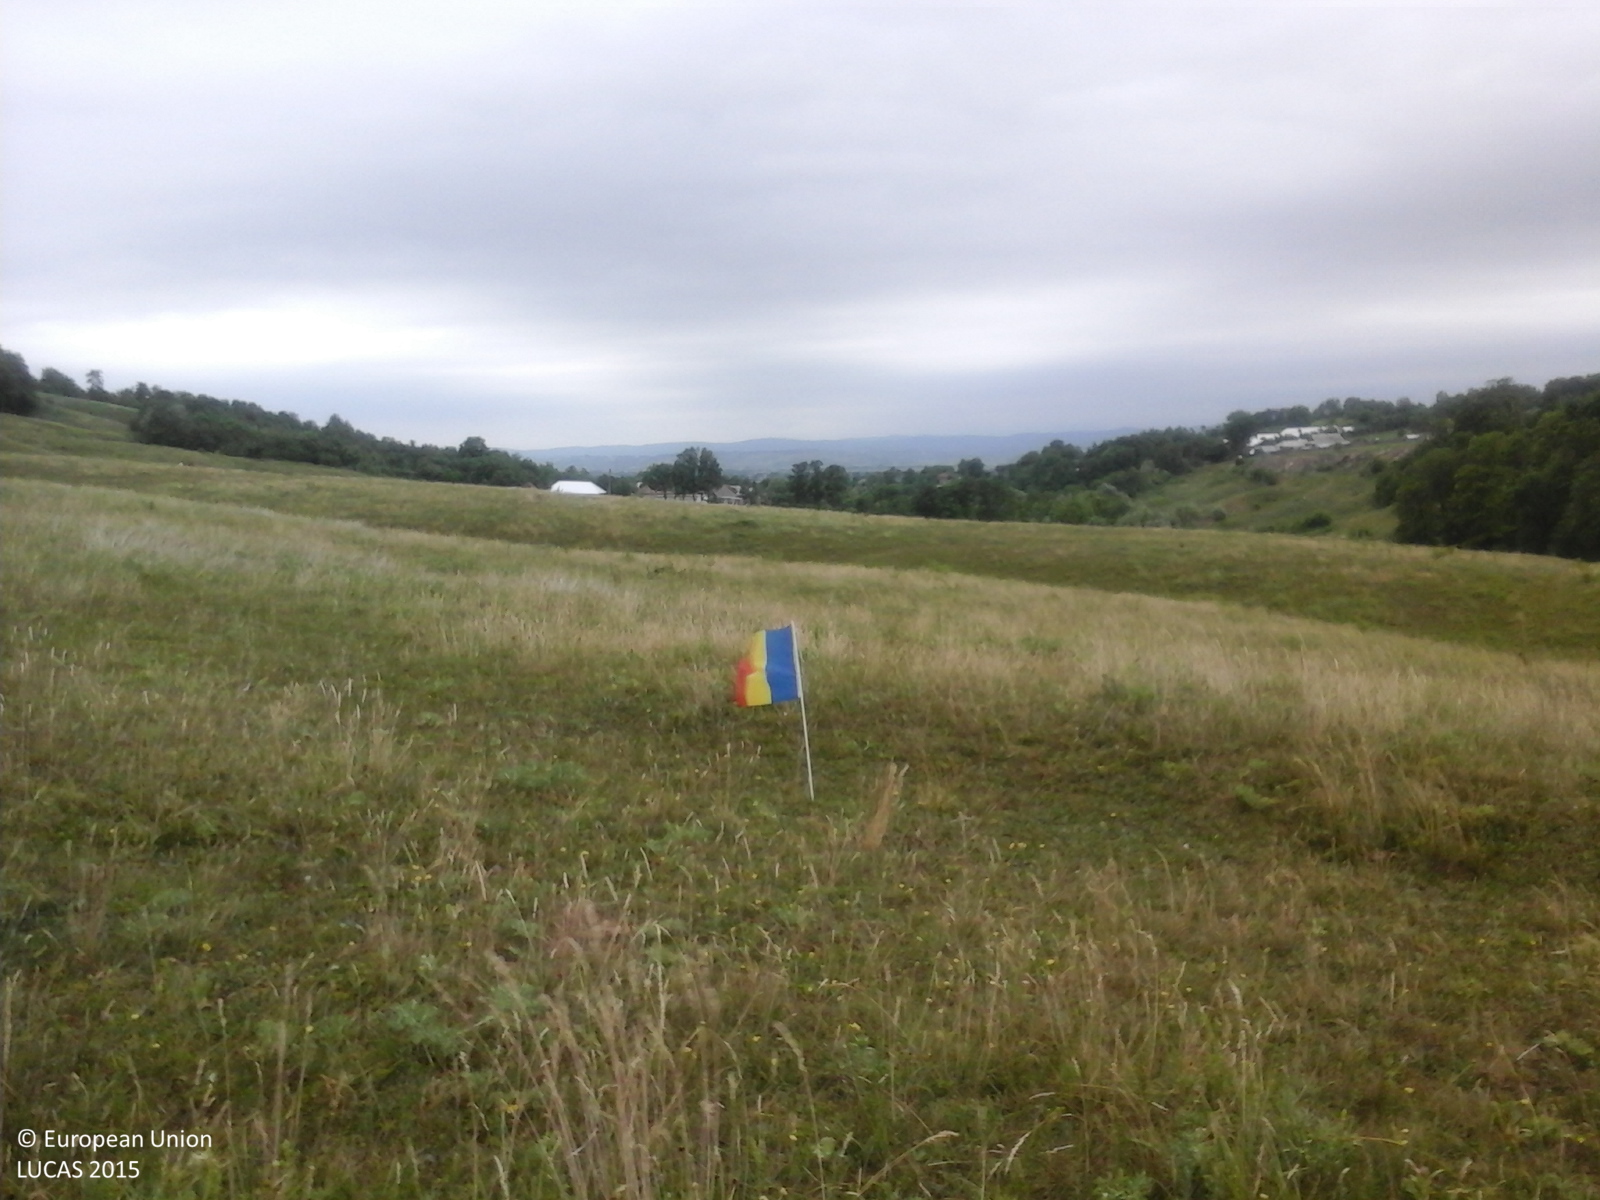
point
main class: Grassland
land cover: Grassland without tree/shrub cover
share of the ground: > 75 %
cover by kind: herbaceous plants 100 %
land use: Agriculture (excluding fallow land and kitchen gardens)
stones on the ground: < 10 %
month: June
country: RO
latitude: 46.8006
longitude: 26.6364
